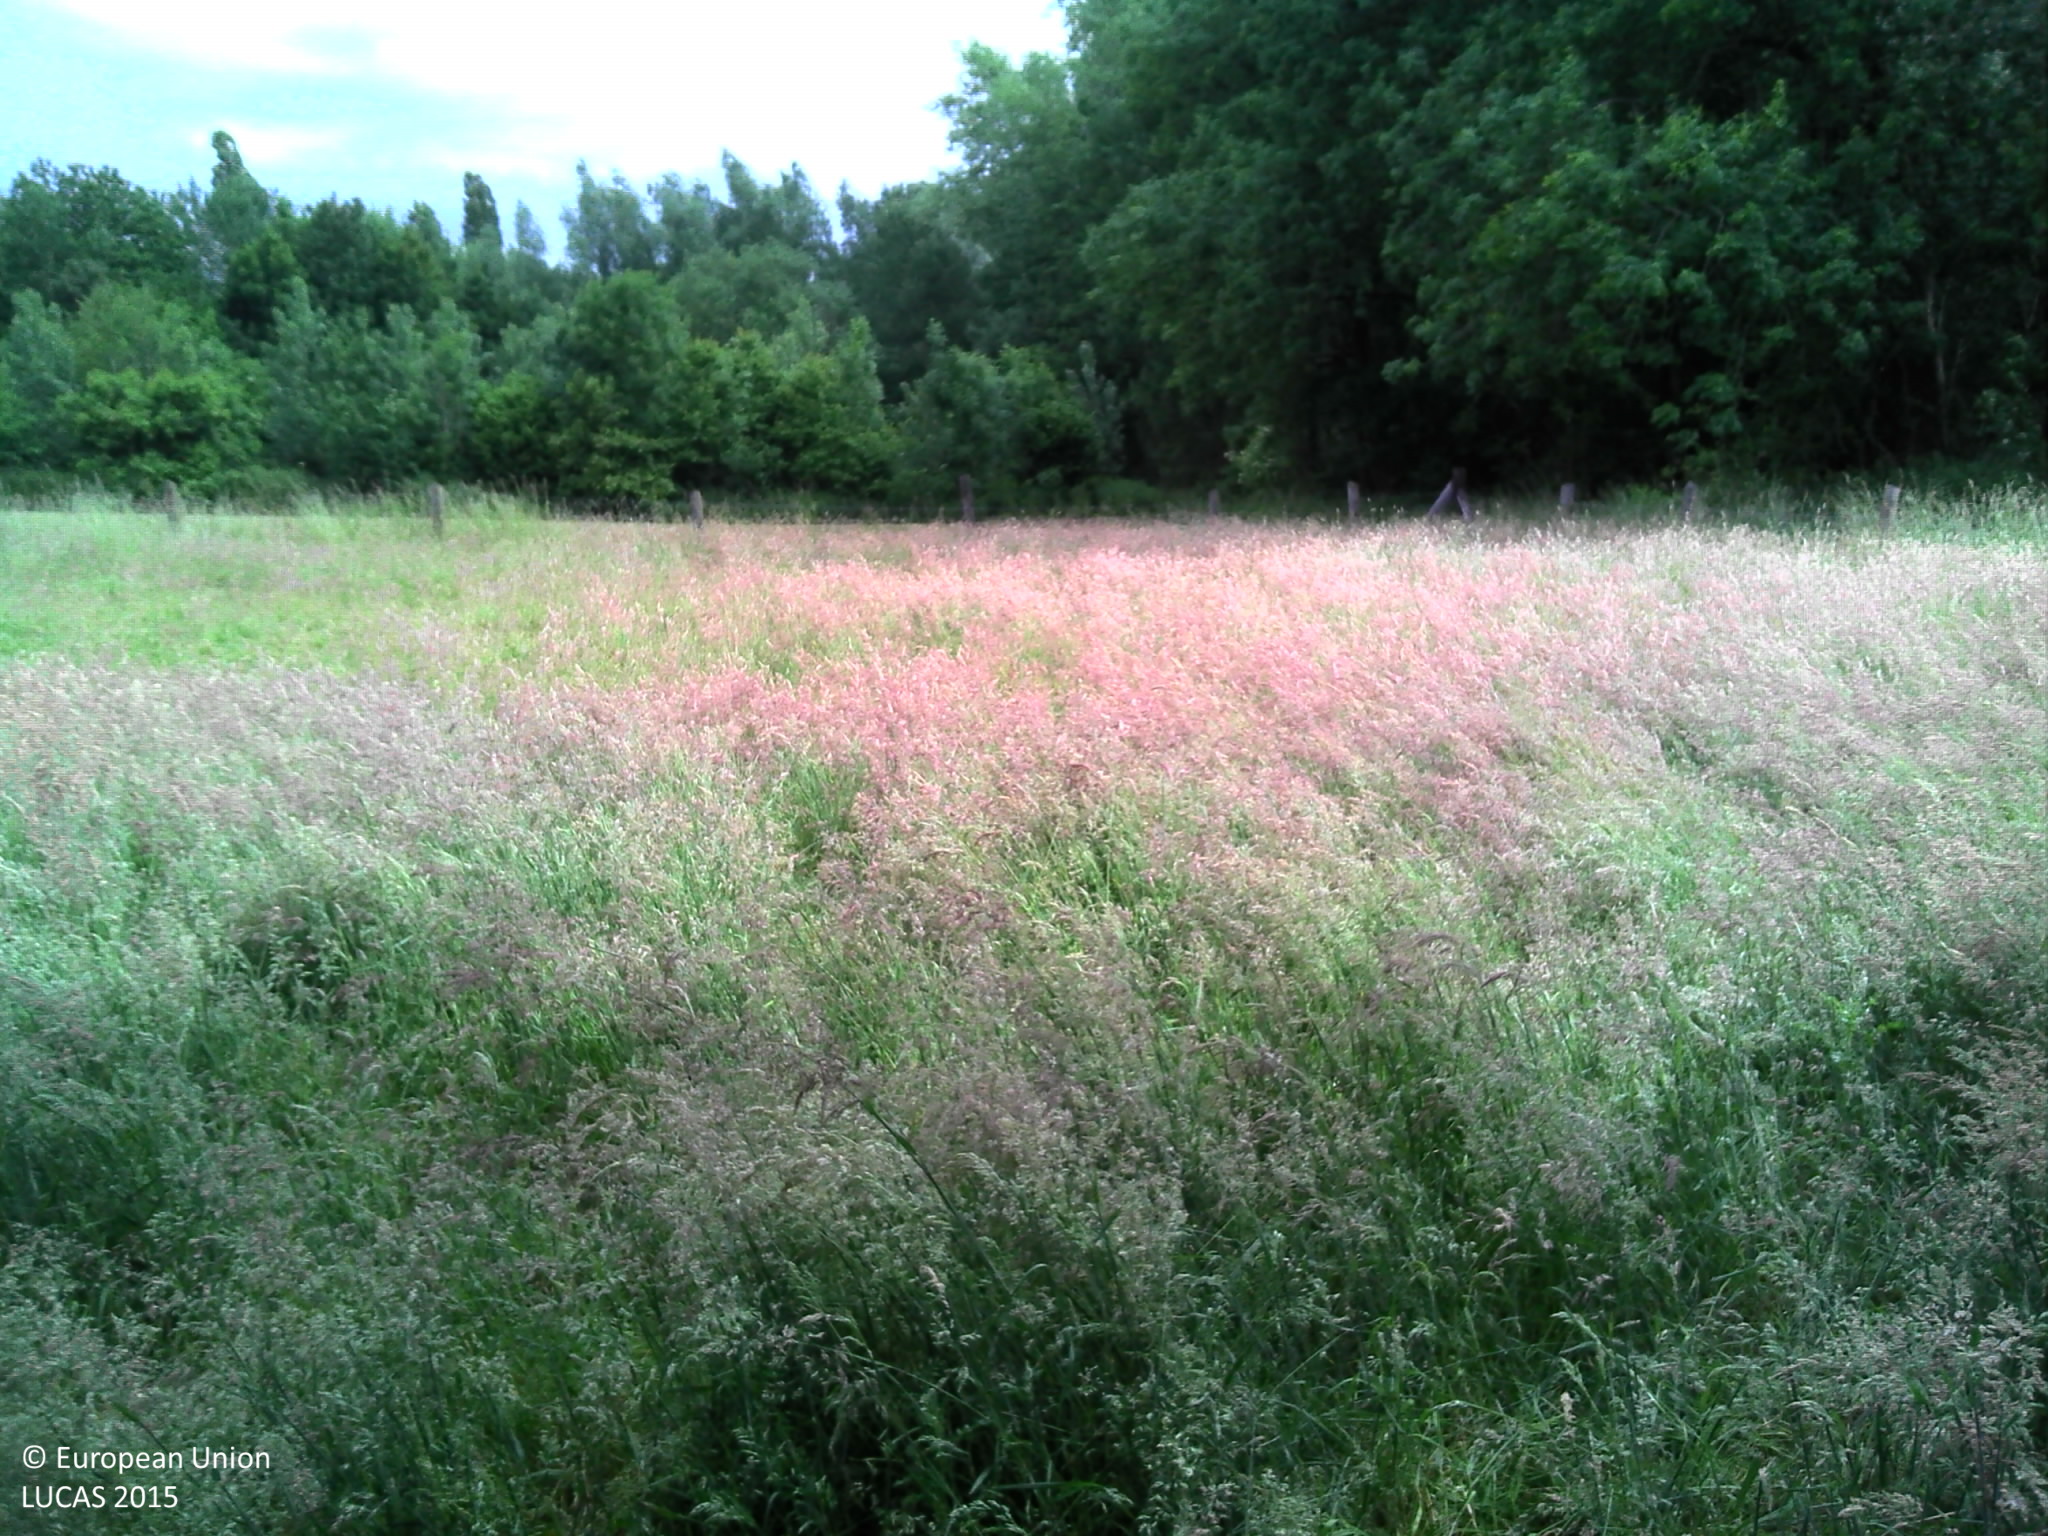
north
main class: Woodland
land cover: Spruce dominated mixed woodland
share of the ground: > 75 %
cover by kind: coniferous forest trees 40 %, broadleaved forest trees 35 %, herbaceous plants 25 %
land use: Forestry
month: June
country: BE
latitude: 50.9338
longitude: 4.1178
